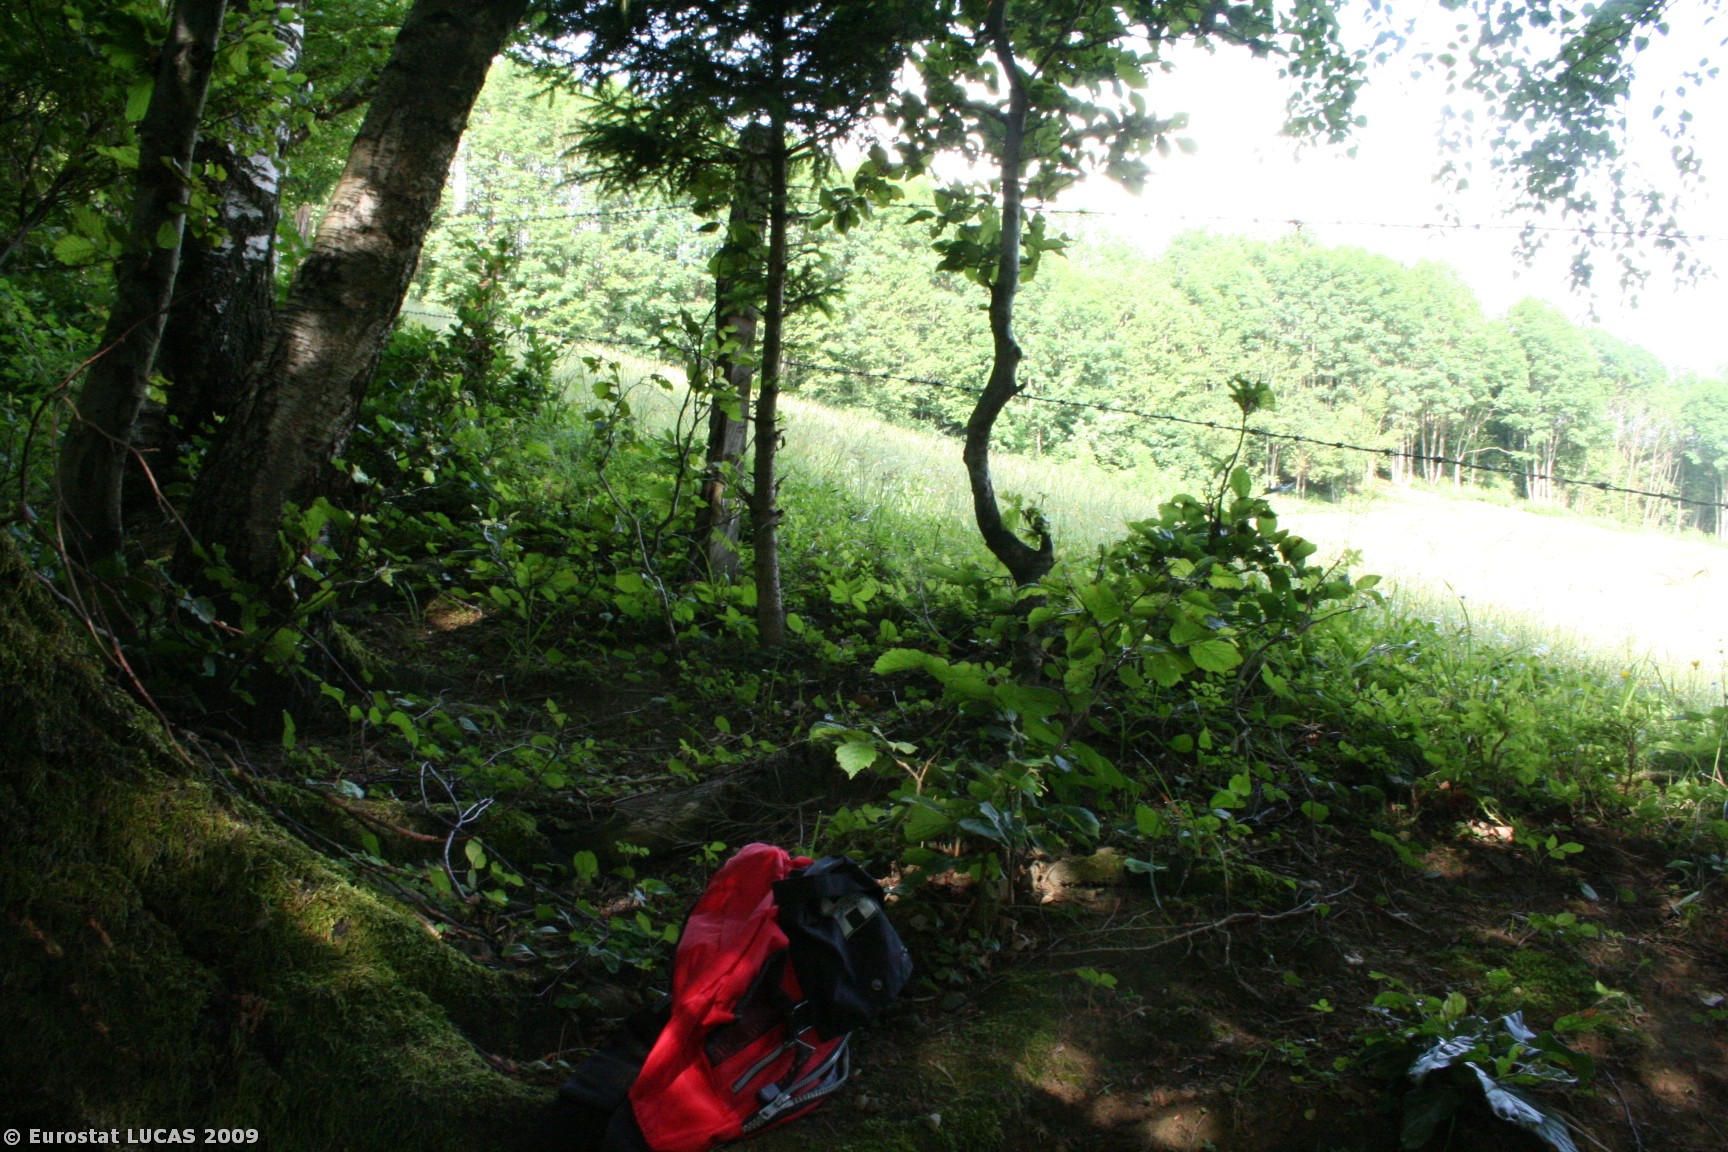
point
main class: Woodland
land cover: Broadleaved woodland
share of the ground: 50 - 75 %
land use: Forestry
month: June
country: AT
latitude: 47.4568
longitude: 13.1950
